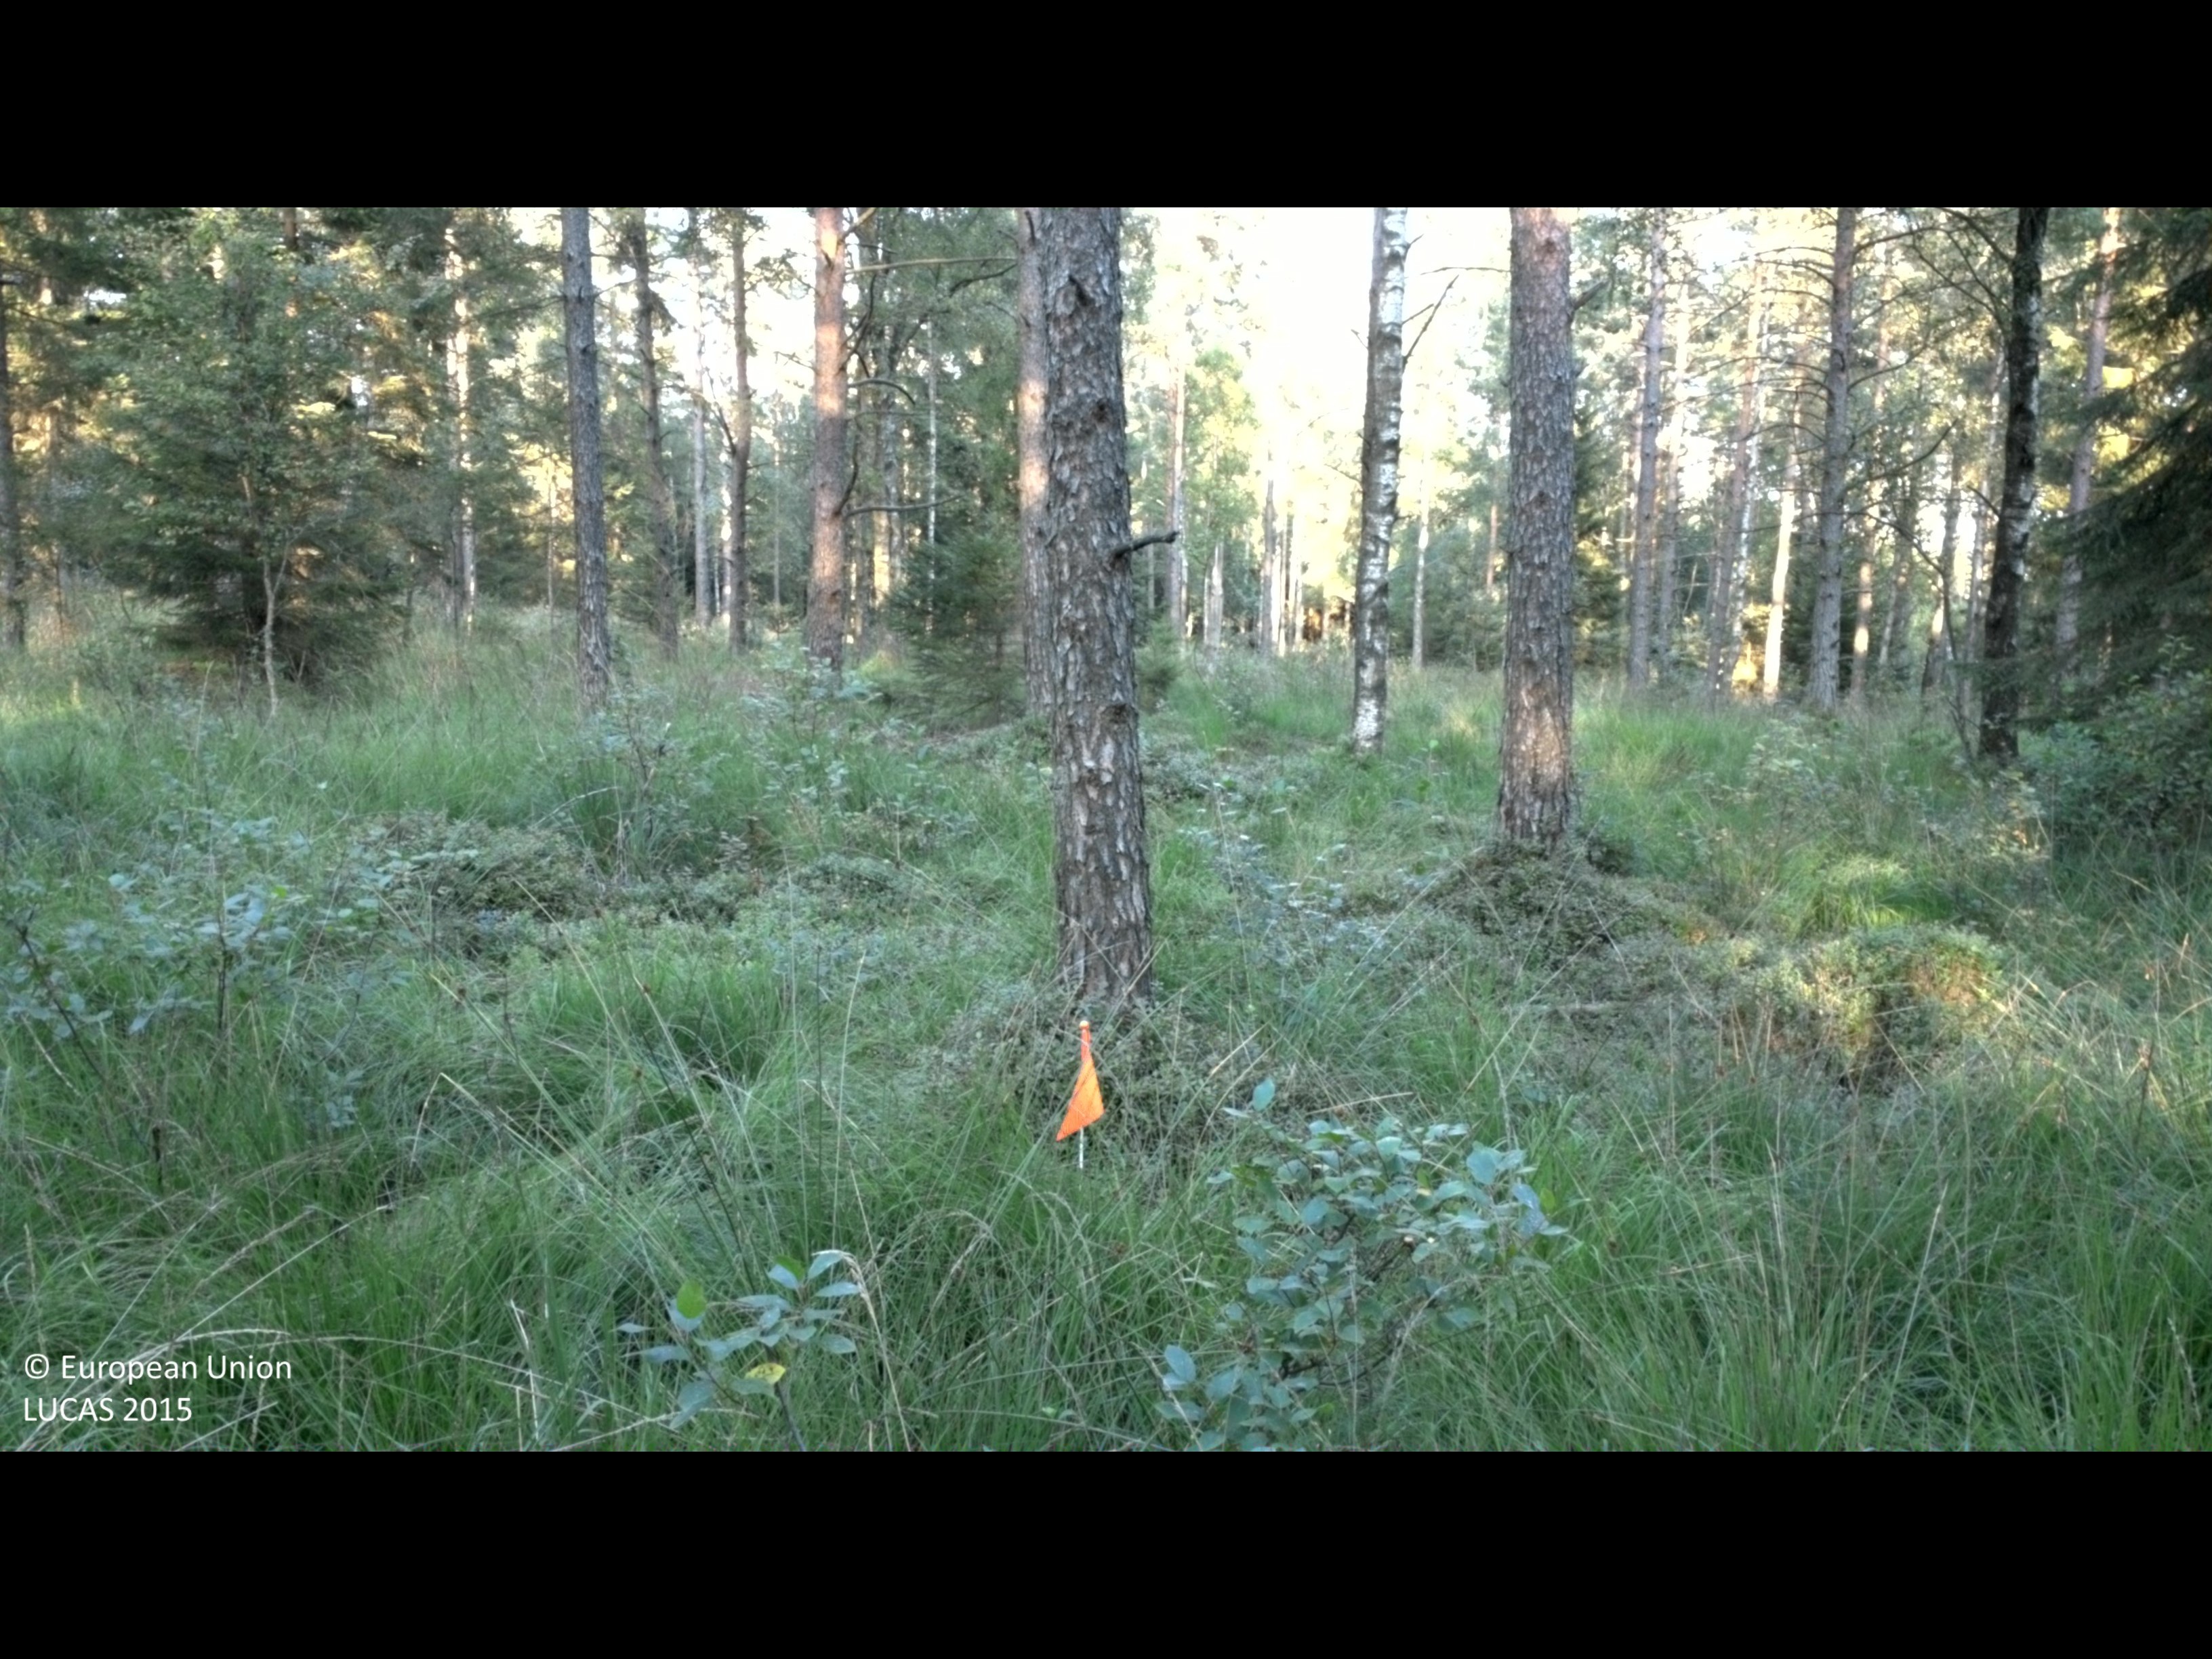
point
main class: Woodland
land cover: Pine dominated mixed woodland
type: boreal forest
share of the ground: 50 - 75 %
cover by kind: coniferous forest trees 45 %, herbaceous plants 30 %, broadleaved forest trees 15 %, shrubs 10 %
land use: Forestry
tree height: > 5 m
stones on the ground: < 10 %
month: August
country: SE
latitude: 56.7428
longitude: 13.1523
